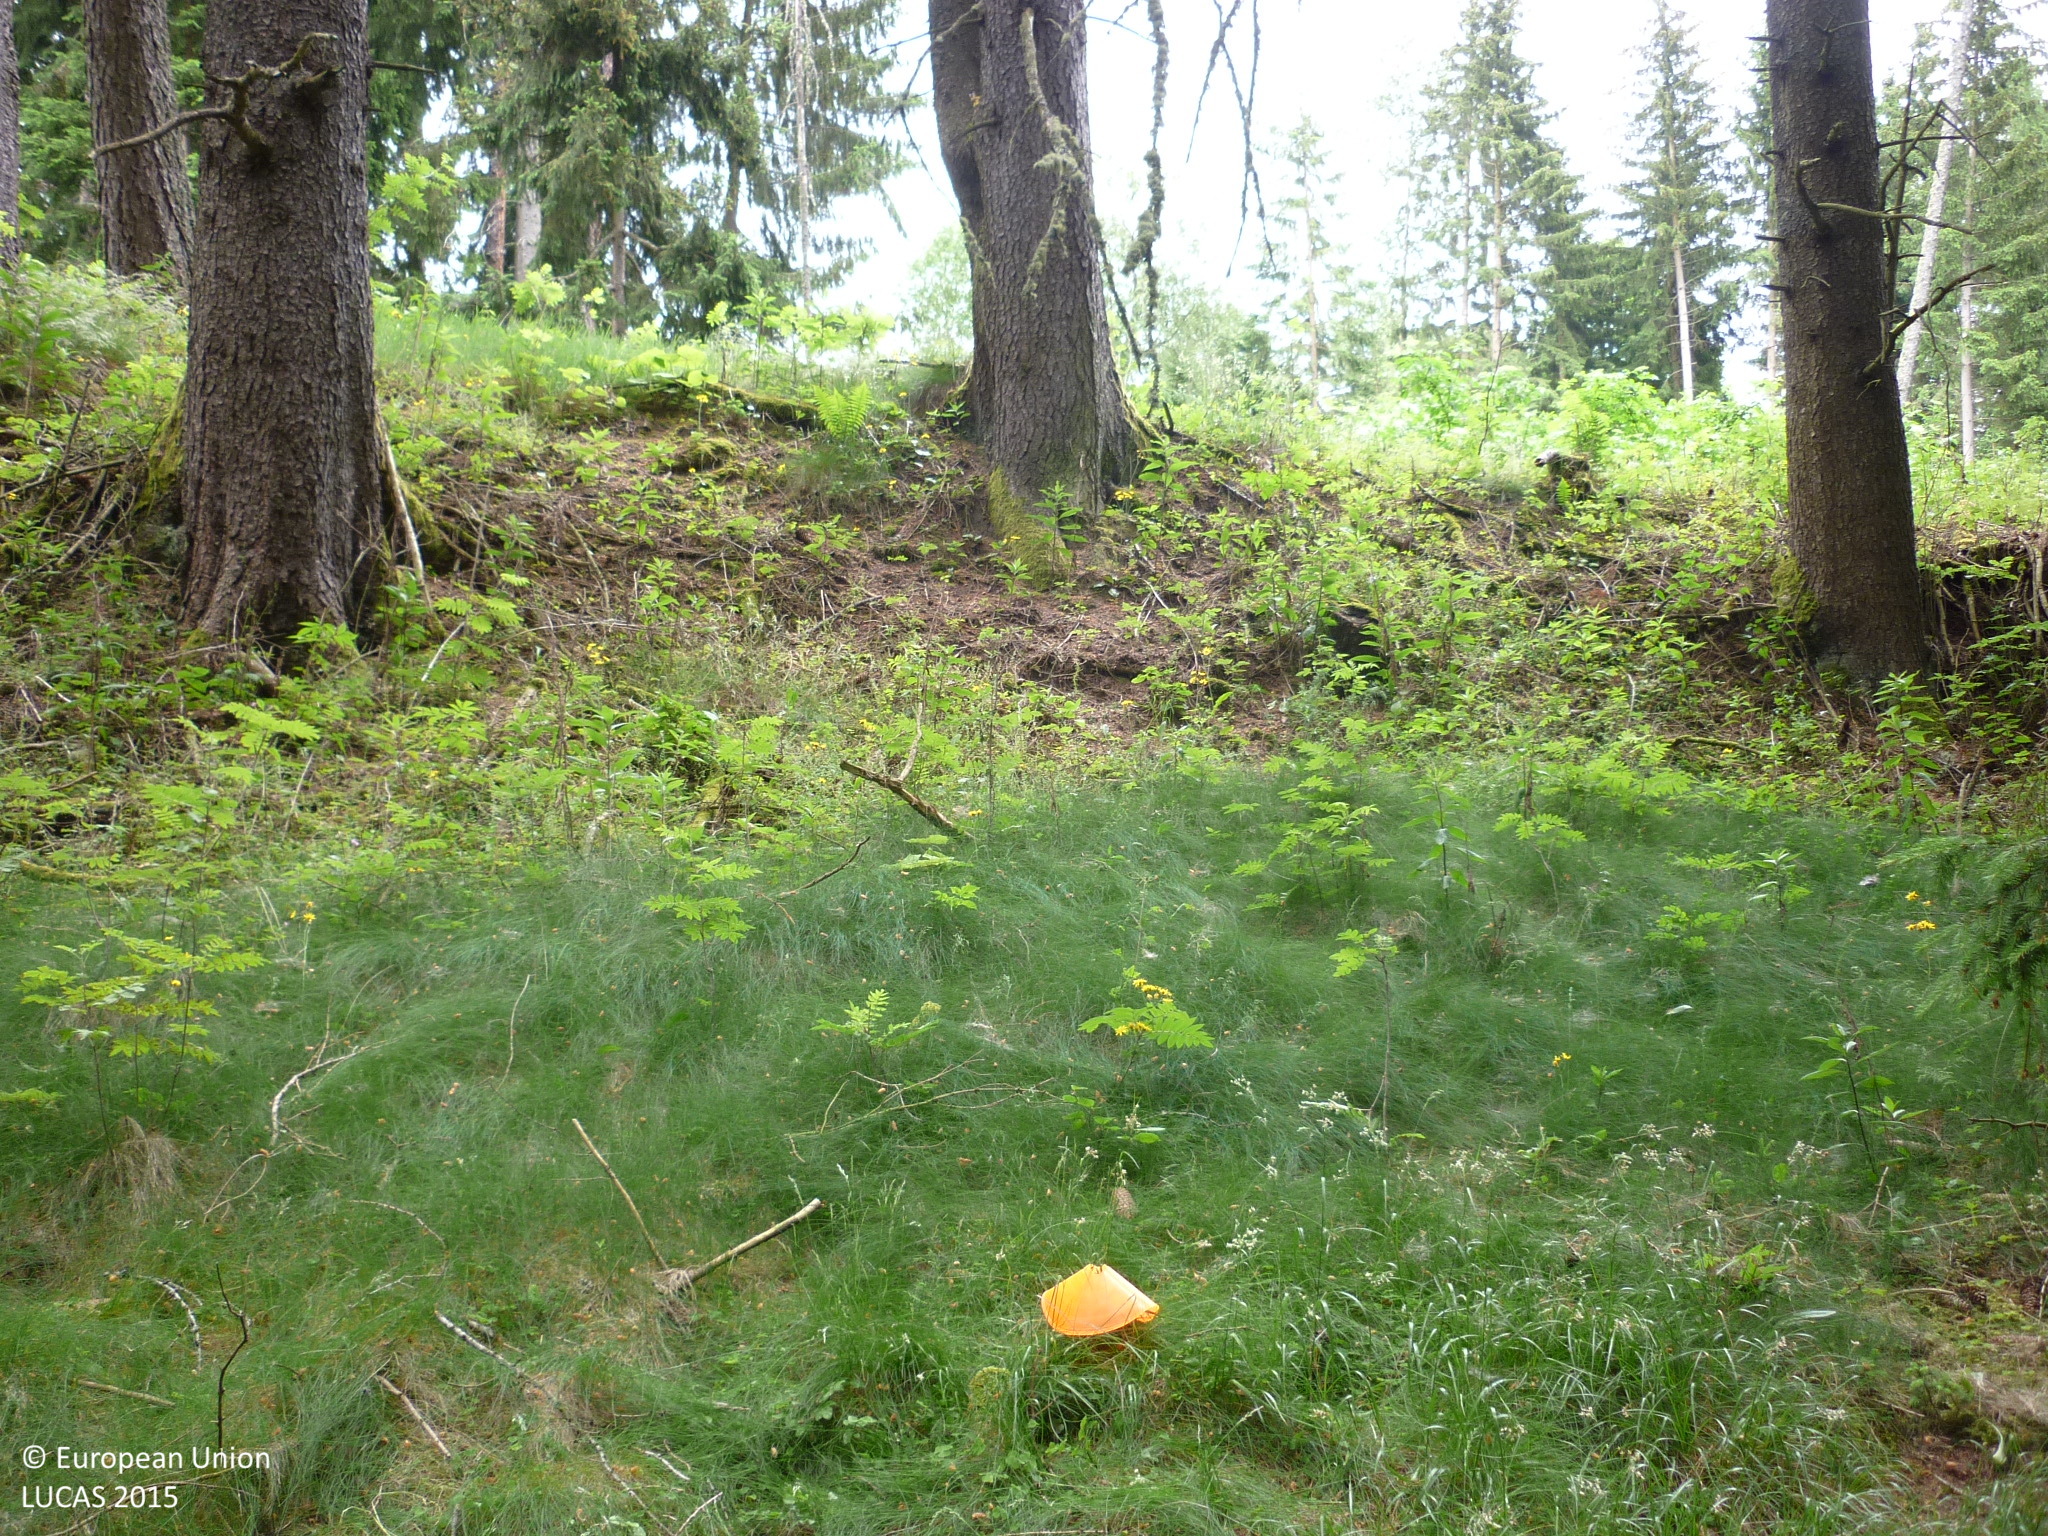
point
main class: Woodland
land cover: Spruce dominated coniferous woodland
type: alpine coniferous forest
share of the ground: 50 - 75 %
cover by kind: coniferous forest trees 60 %, herbaceous plants 35 %, shrubs 5 %
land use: Forestry
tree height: > 5 m
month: June
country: AT
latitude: 47.0697
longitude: 14.4624
